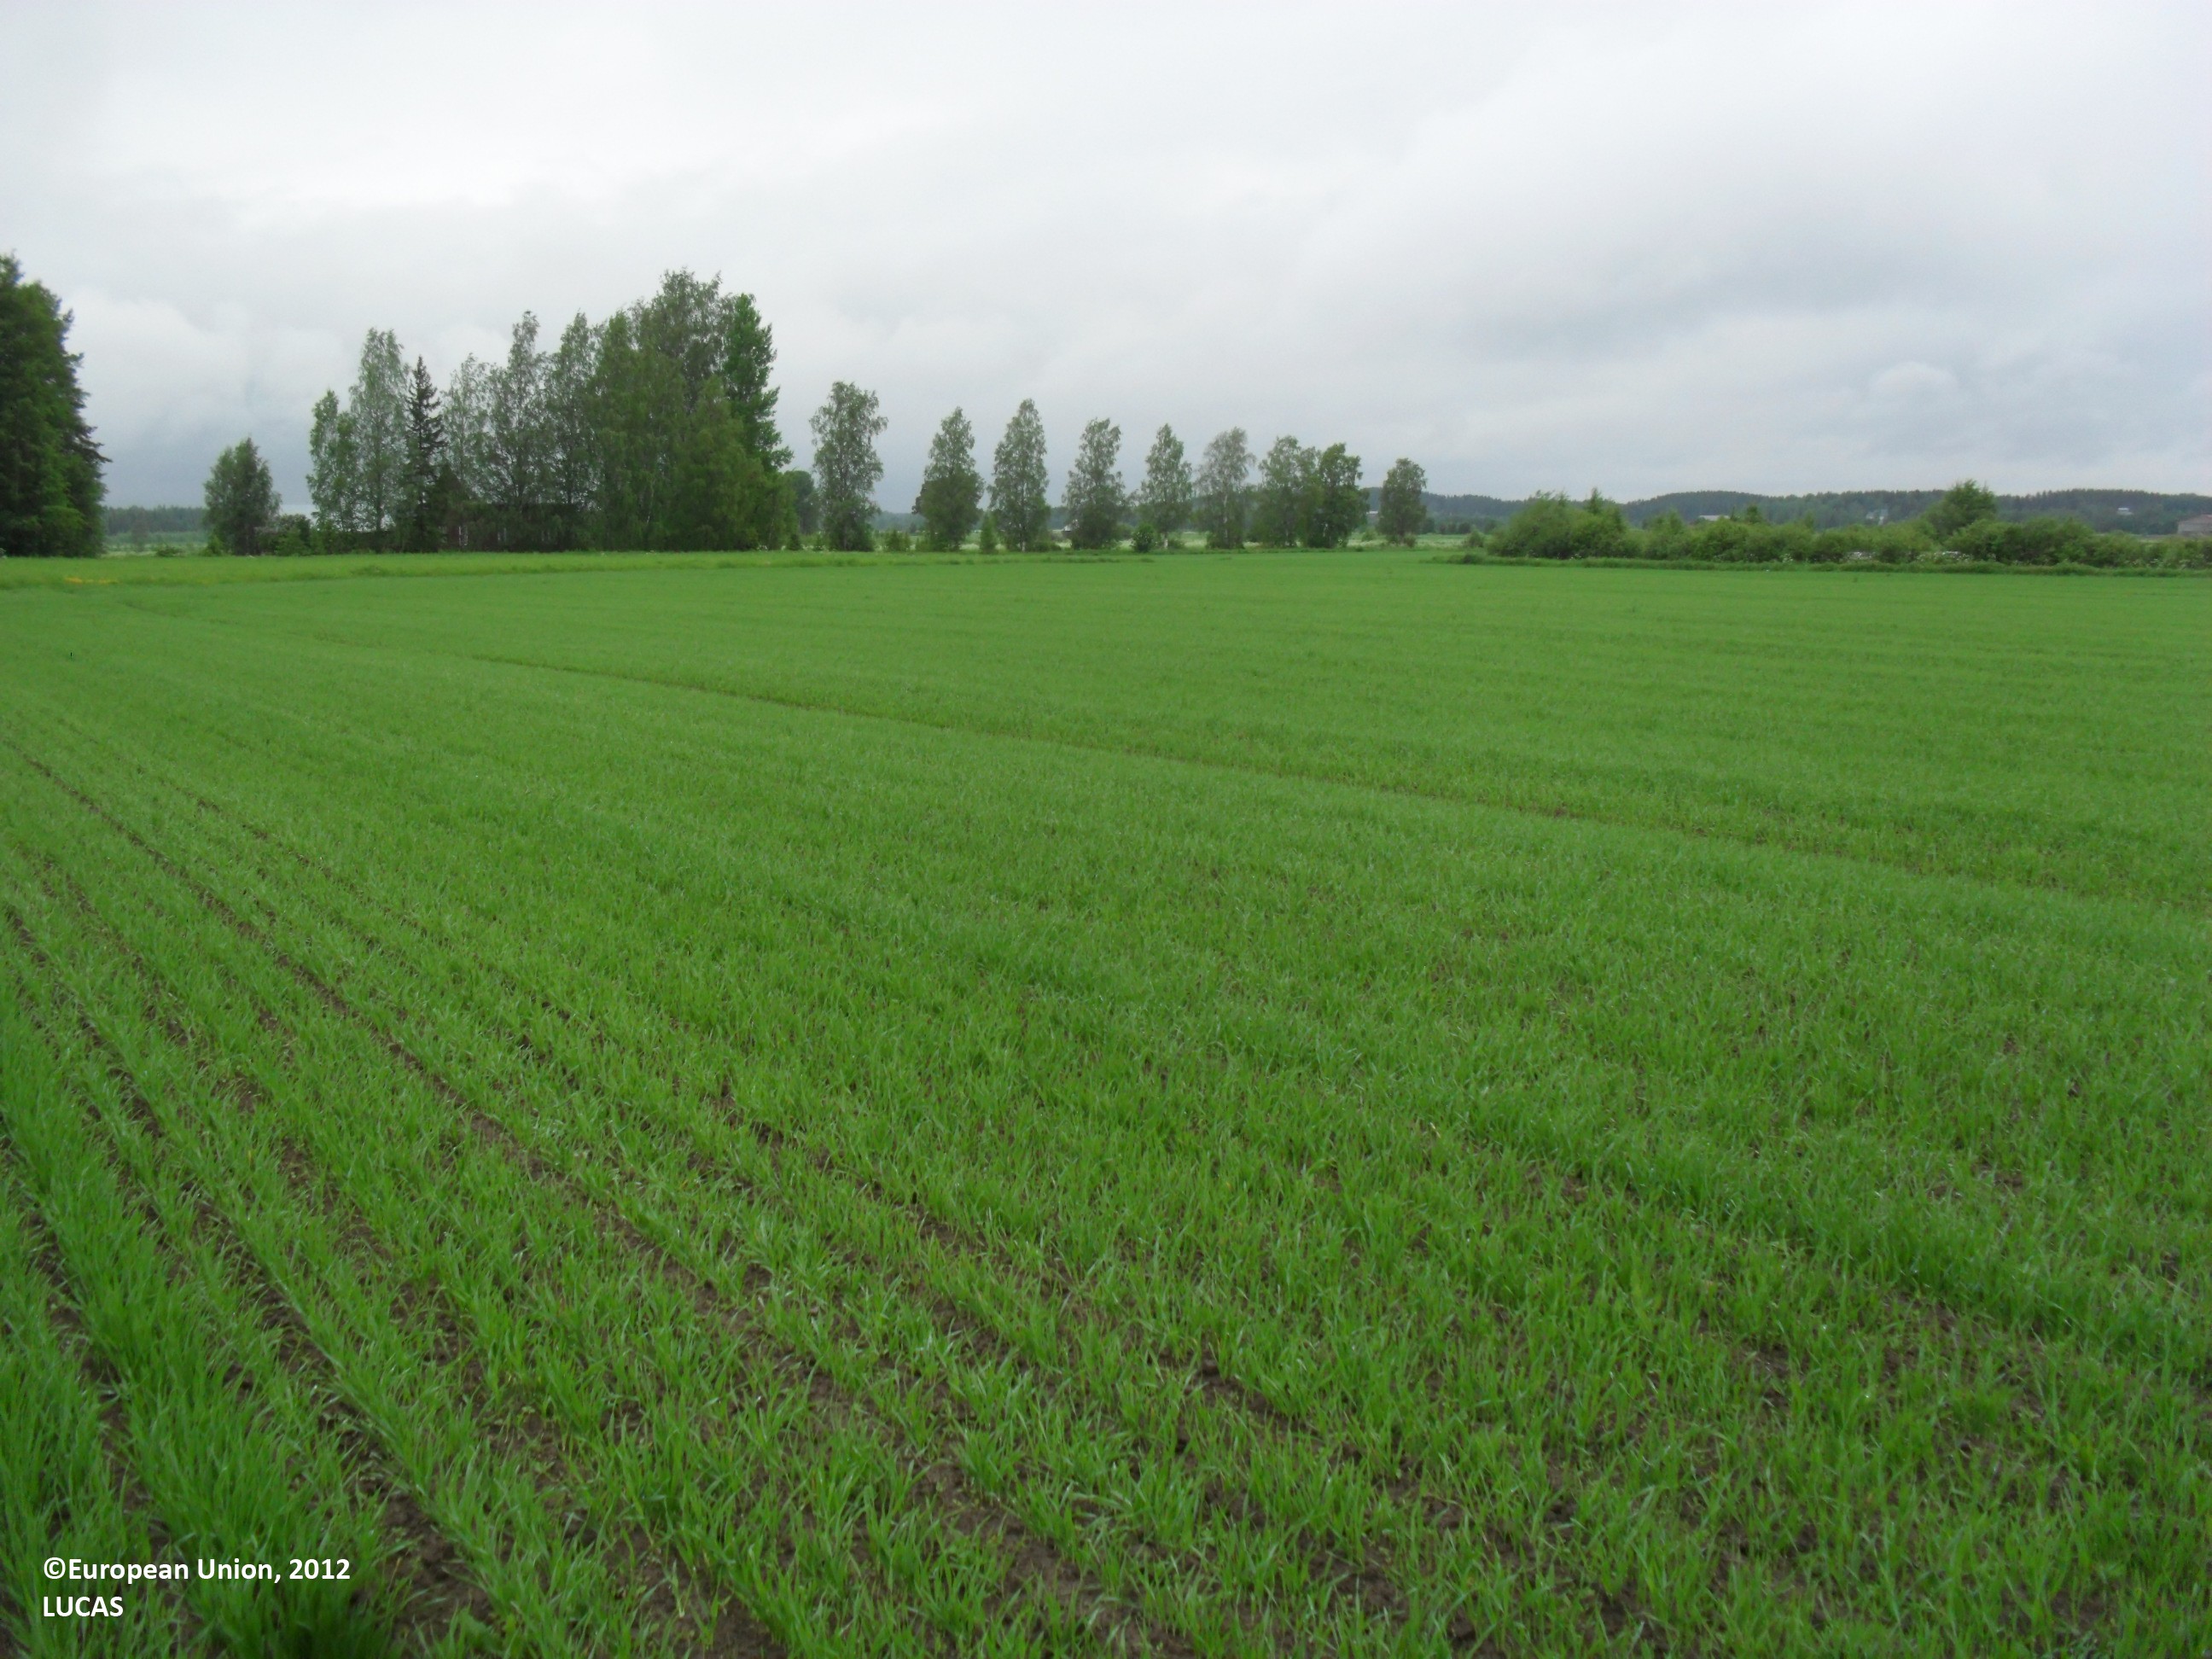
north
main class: Cropland
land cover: Barley
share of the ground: 50 - 75 %
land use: Agriculture (excluding fallow land and kitchen gardens)
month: June
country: FI
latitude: 63.0745
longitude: 23.1843
